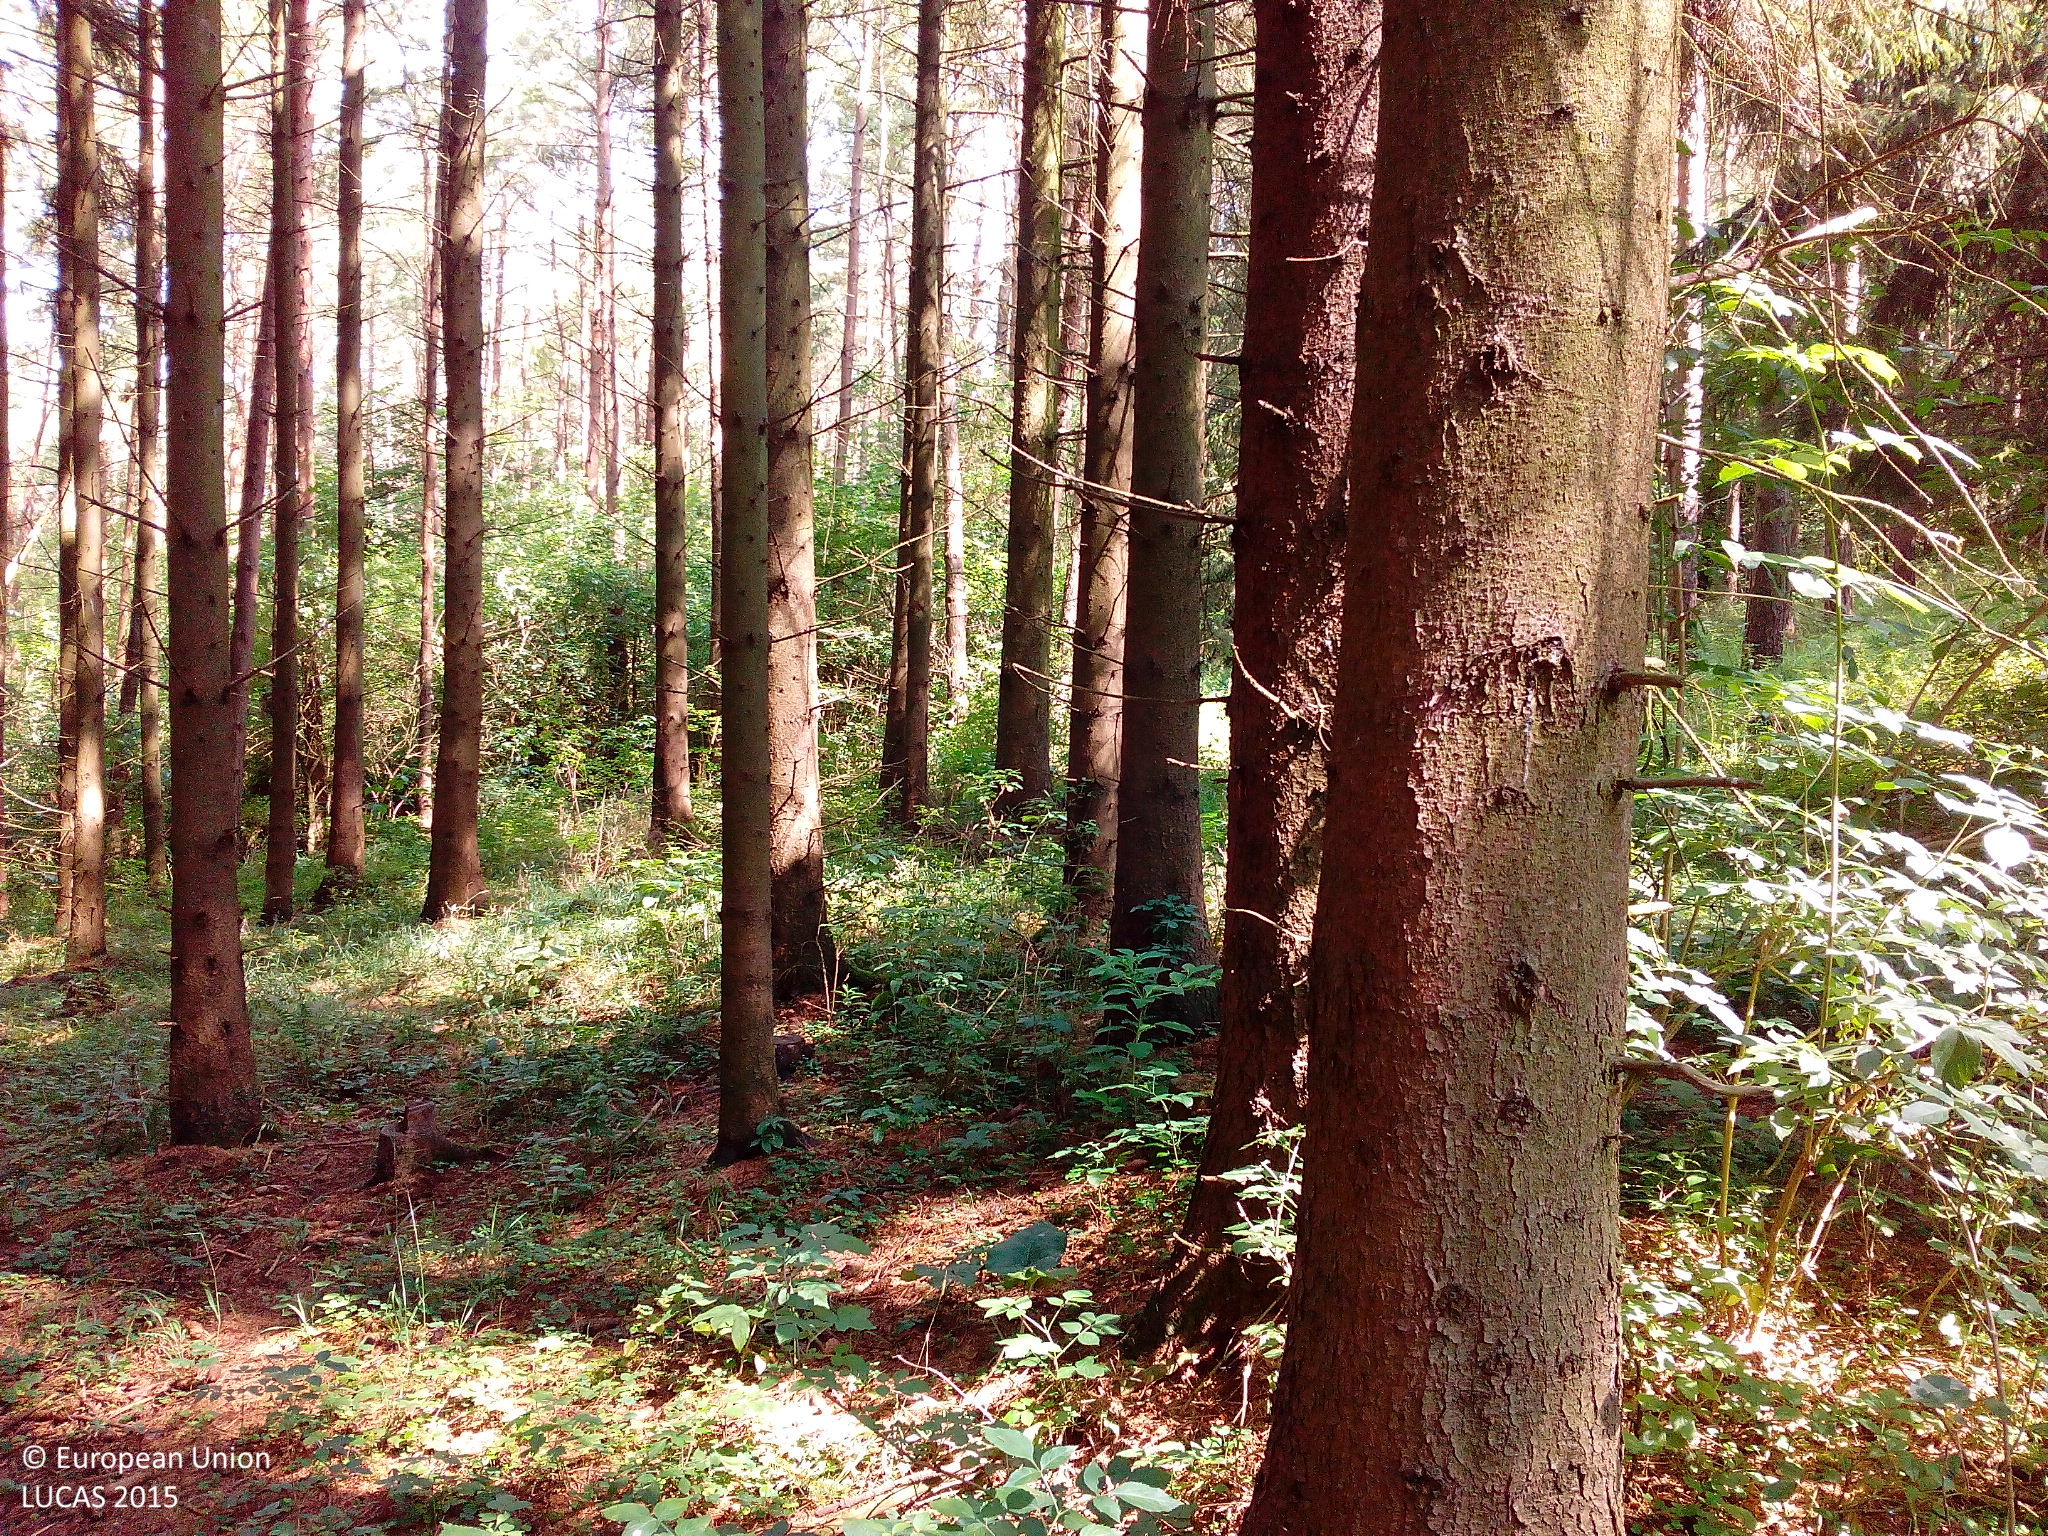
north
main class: Woodland
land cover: Spruce dominated coniferous woodland
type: hemiboreal forest and nemoral coniferous forest and mixed broadleaved-coniferous forest
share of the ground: > 75 %
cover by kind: coniferous forest trees 90 %, broadleaved forest trees 5 %, herbaceous plants 5 %
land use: Forestry
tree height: > 5 m
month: July
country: DE
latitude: 50.6517
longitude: 9.9576
